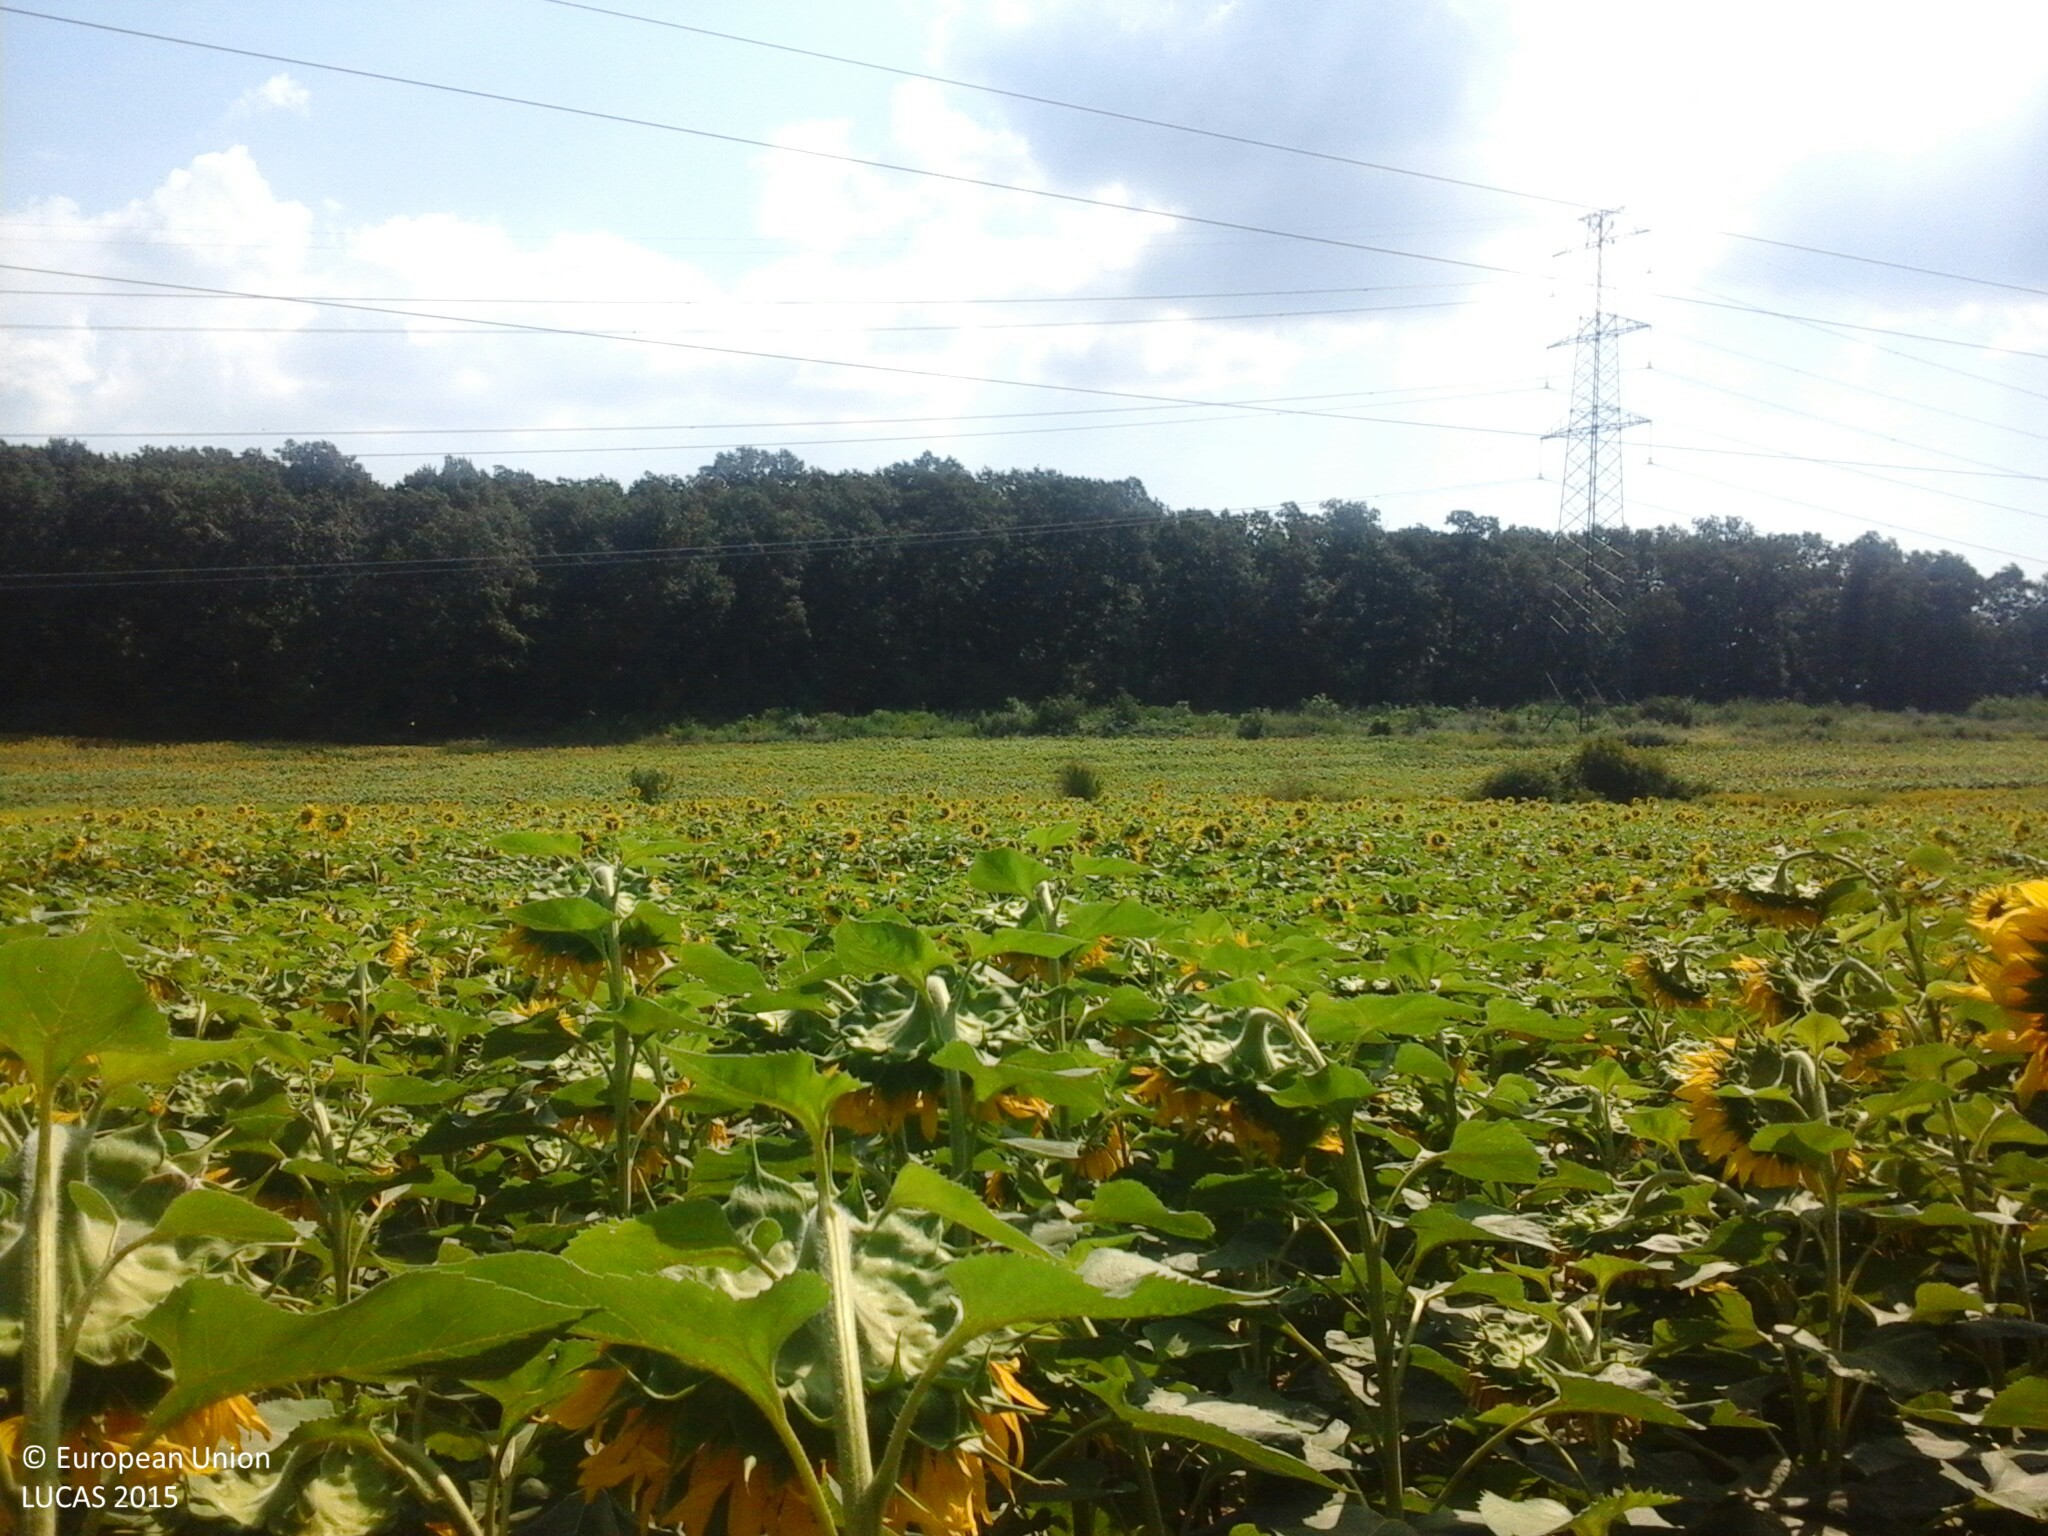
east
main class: Cropland
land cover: Sunflower
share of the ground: > 75 %
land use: Agriculture (excluding fallow land and kitchen gardens)
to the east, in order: Sunflower; Electric lines; Sunflower; Grass margins; Ditches and canals; Grass margins; Sunflower; Electric lines; Broadleaved woodland; Tracks; Broadleaved woodland
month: August
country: HU
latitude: 47.4914
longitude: 18.3350
